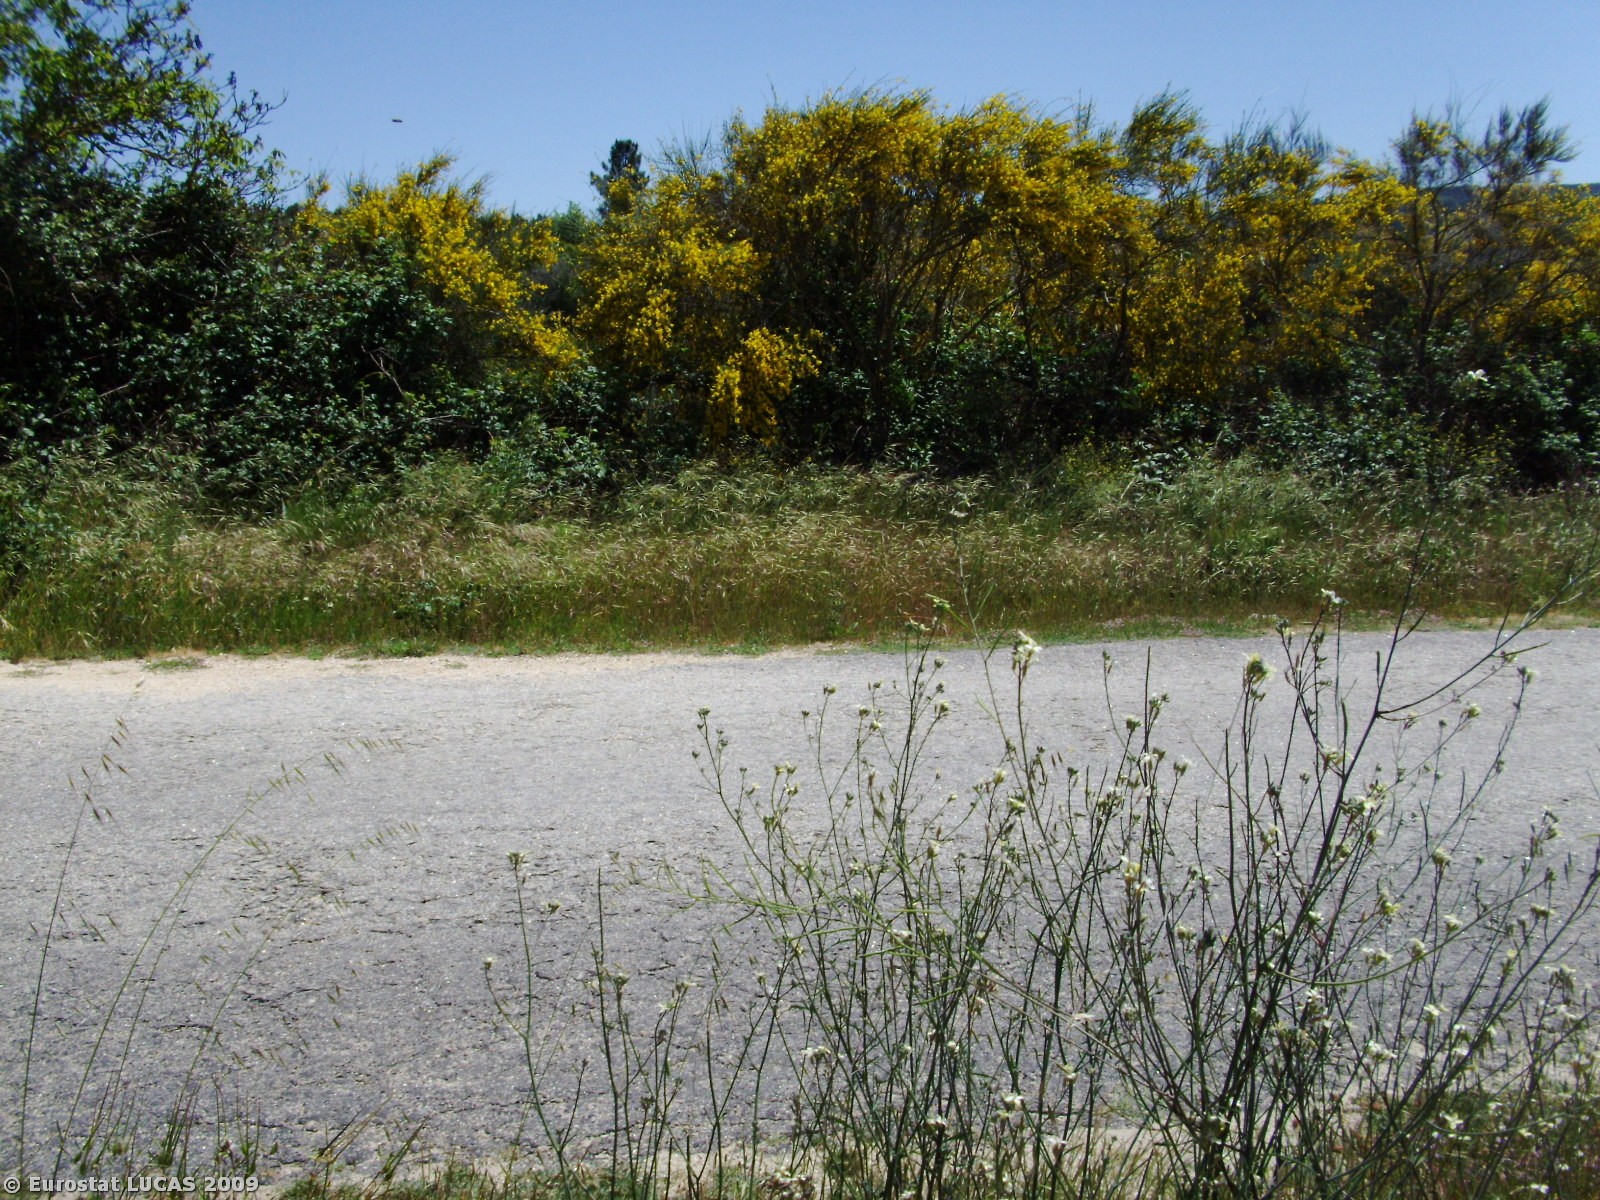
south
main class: Shrubland
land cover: Shrubland without tree cover
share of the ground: > 75 %
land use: Unused
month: May
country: PT
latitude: 40.9733
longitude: -7.5780
